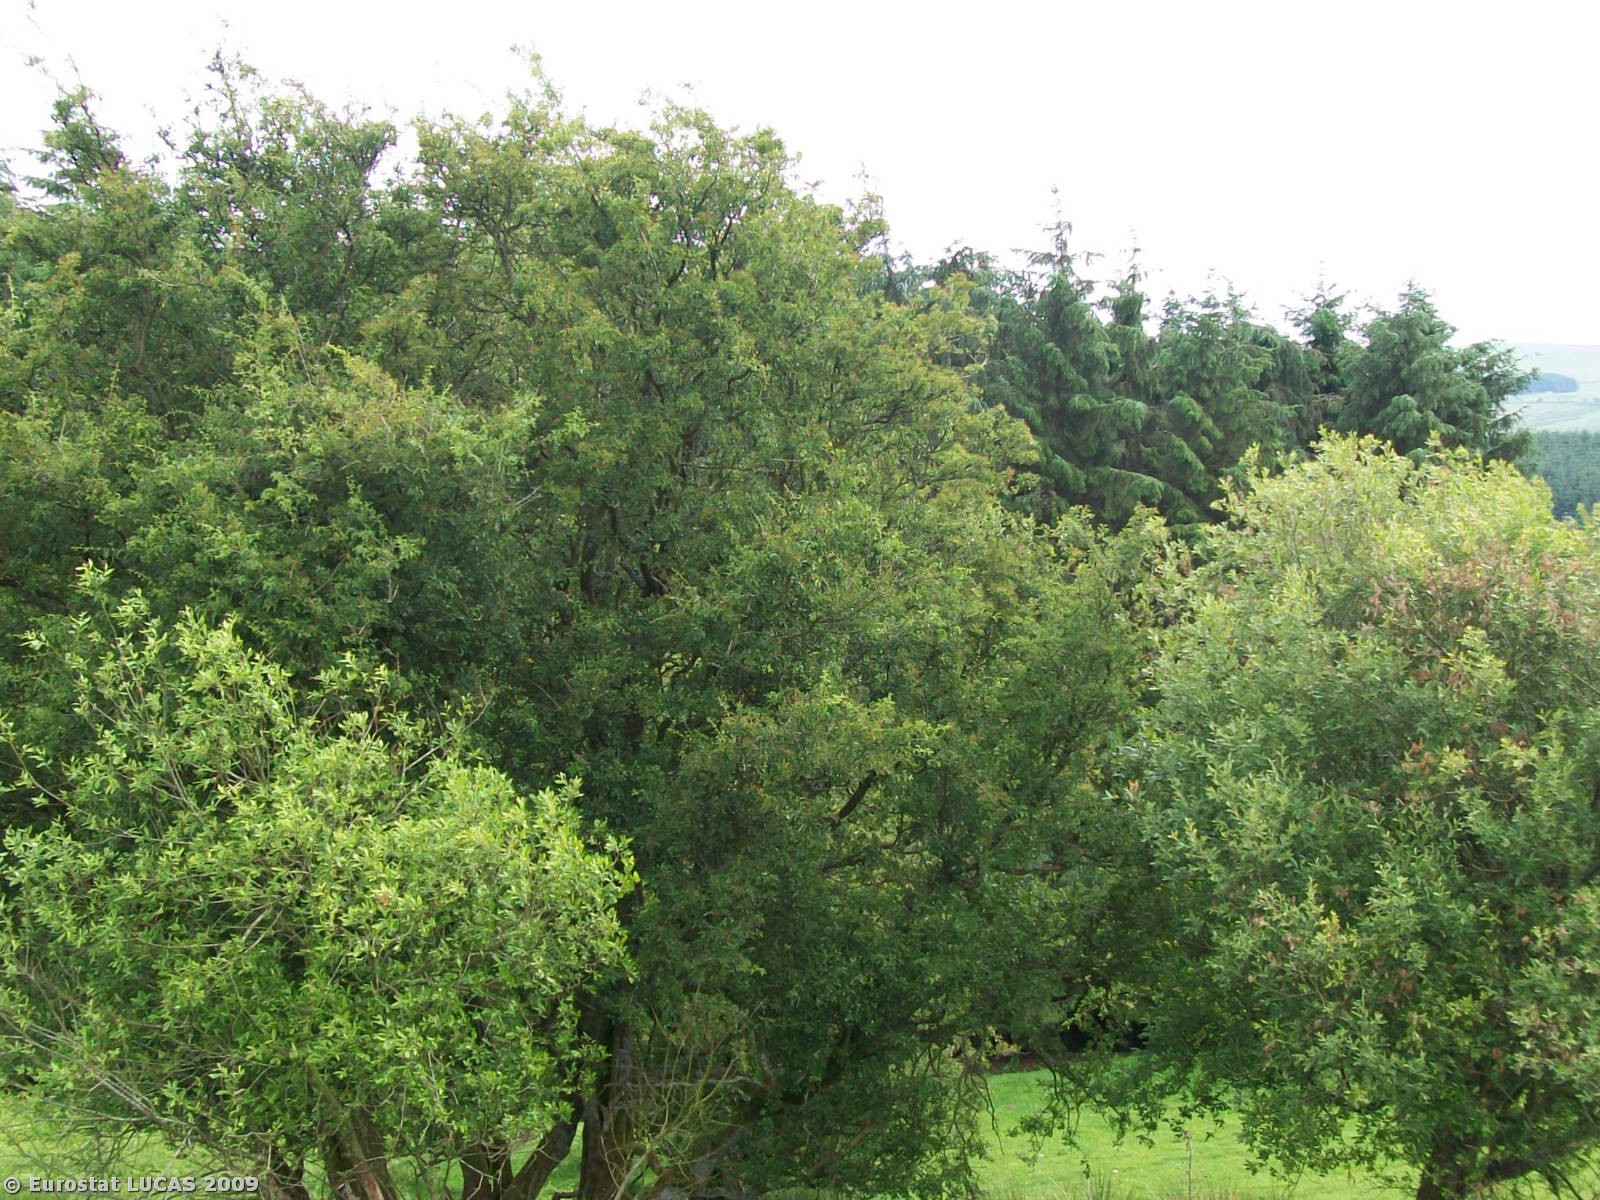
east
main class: Grassland
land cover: Grassland without tree/shrub cover
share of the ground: > 75 %
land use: Agriculture (excluding fallow land and kitchen gardens)
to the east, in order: Grassland without tree/shrub cover; Tracks; Grass margins; Fences; Coniferous woodland; Managed hedges; Grassland without tree/shrub cover
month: June
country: GB
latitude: 53.1315
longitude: -3.5209
